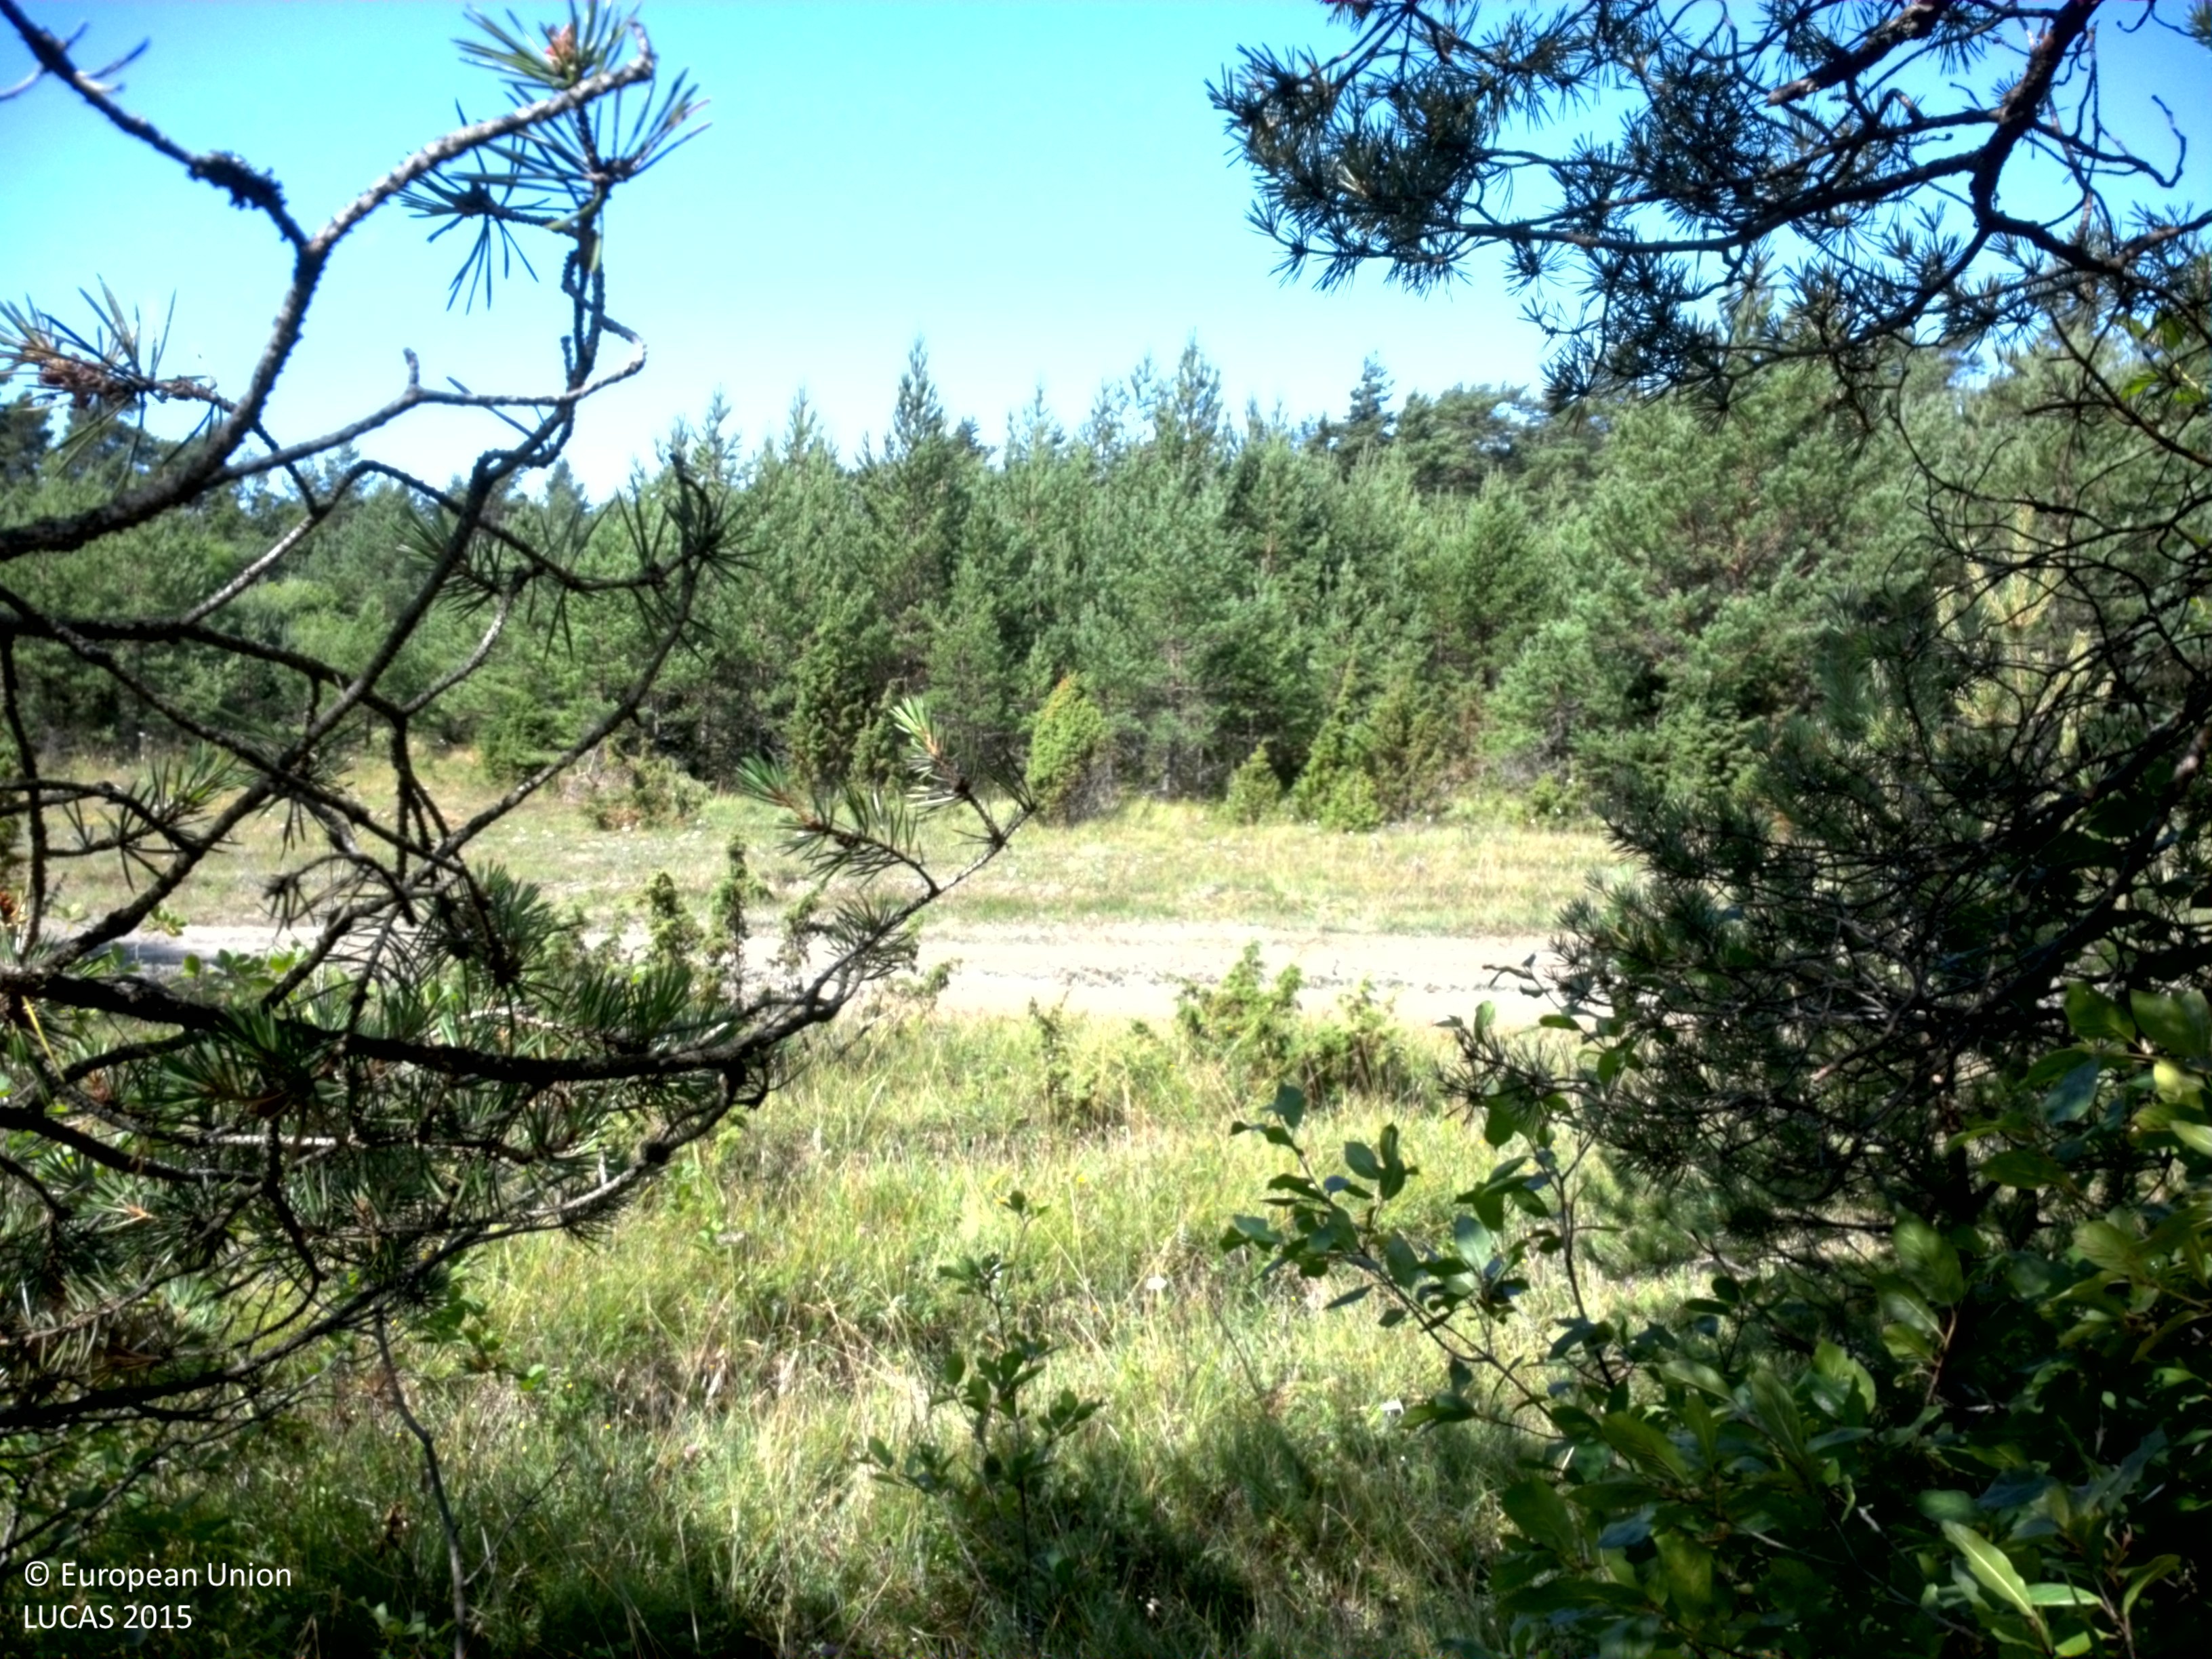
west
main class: Woodland
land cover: Pine dominated mixed woodland
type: hemiboreal forest and nemoral coniferous forest and mixed broadleaved-coniferous forest
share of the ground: > 75 %
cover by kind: coniferous forest trees 55 %, broadleaved forest trees 20 %, herbaceous plants 15 %, shrubs 10 %
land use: Forestry
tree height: > 5 m
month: July
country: SE
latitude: 57.2089
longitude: 18.2028
